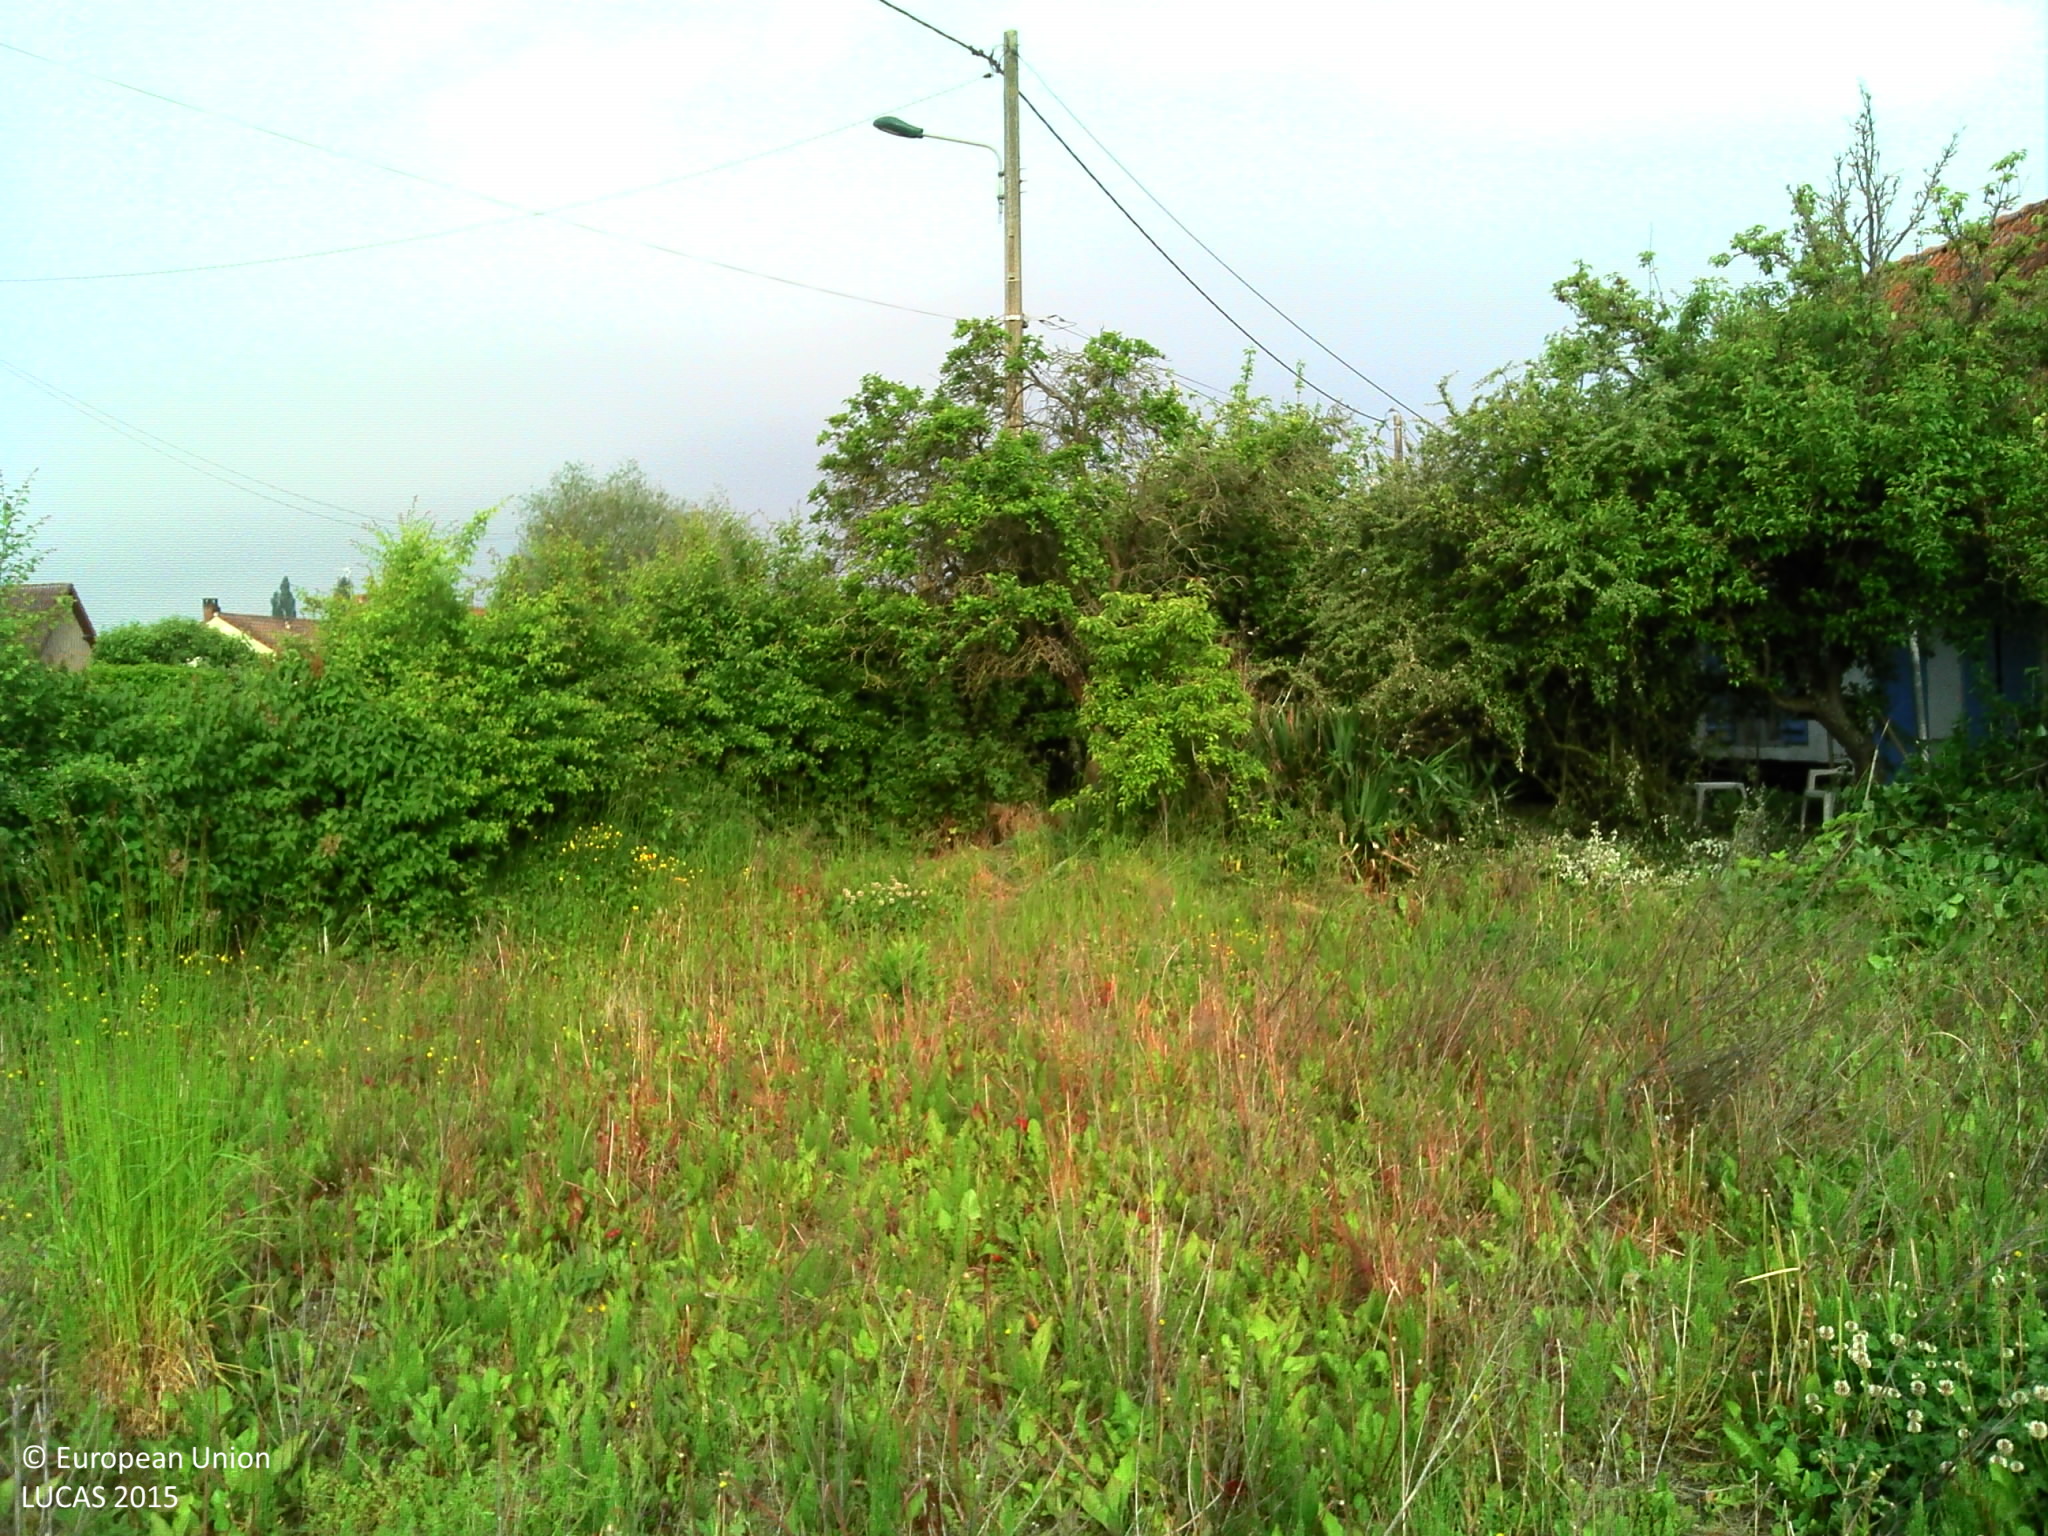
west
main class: Grassland
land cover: Spontaneously vegetated surfaces
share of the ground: > 75 %
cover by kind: herbaceous plants 50 %, unconsolidated bare surface 20 %
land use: Residential
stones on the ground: < 10 %
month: May
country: FR
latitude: 50.6363
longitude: 2.4224
